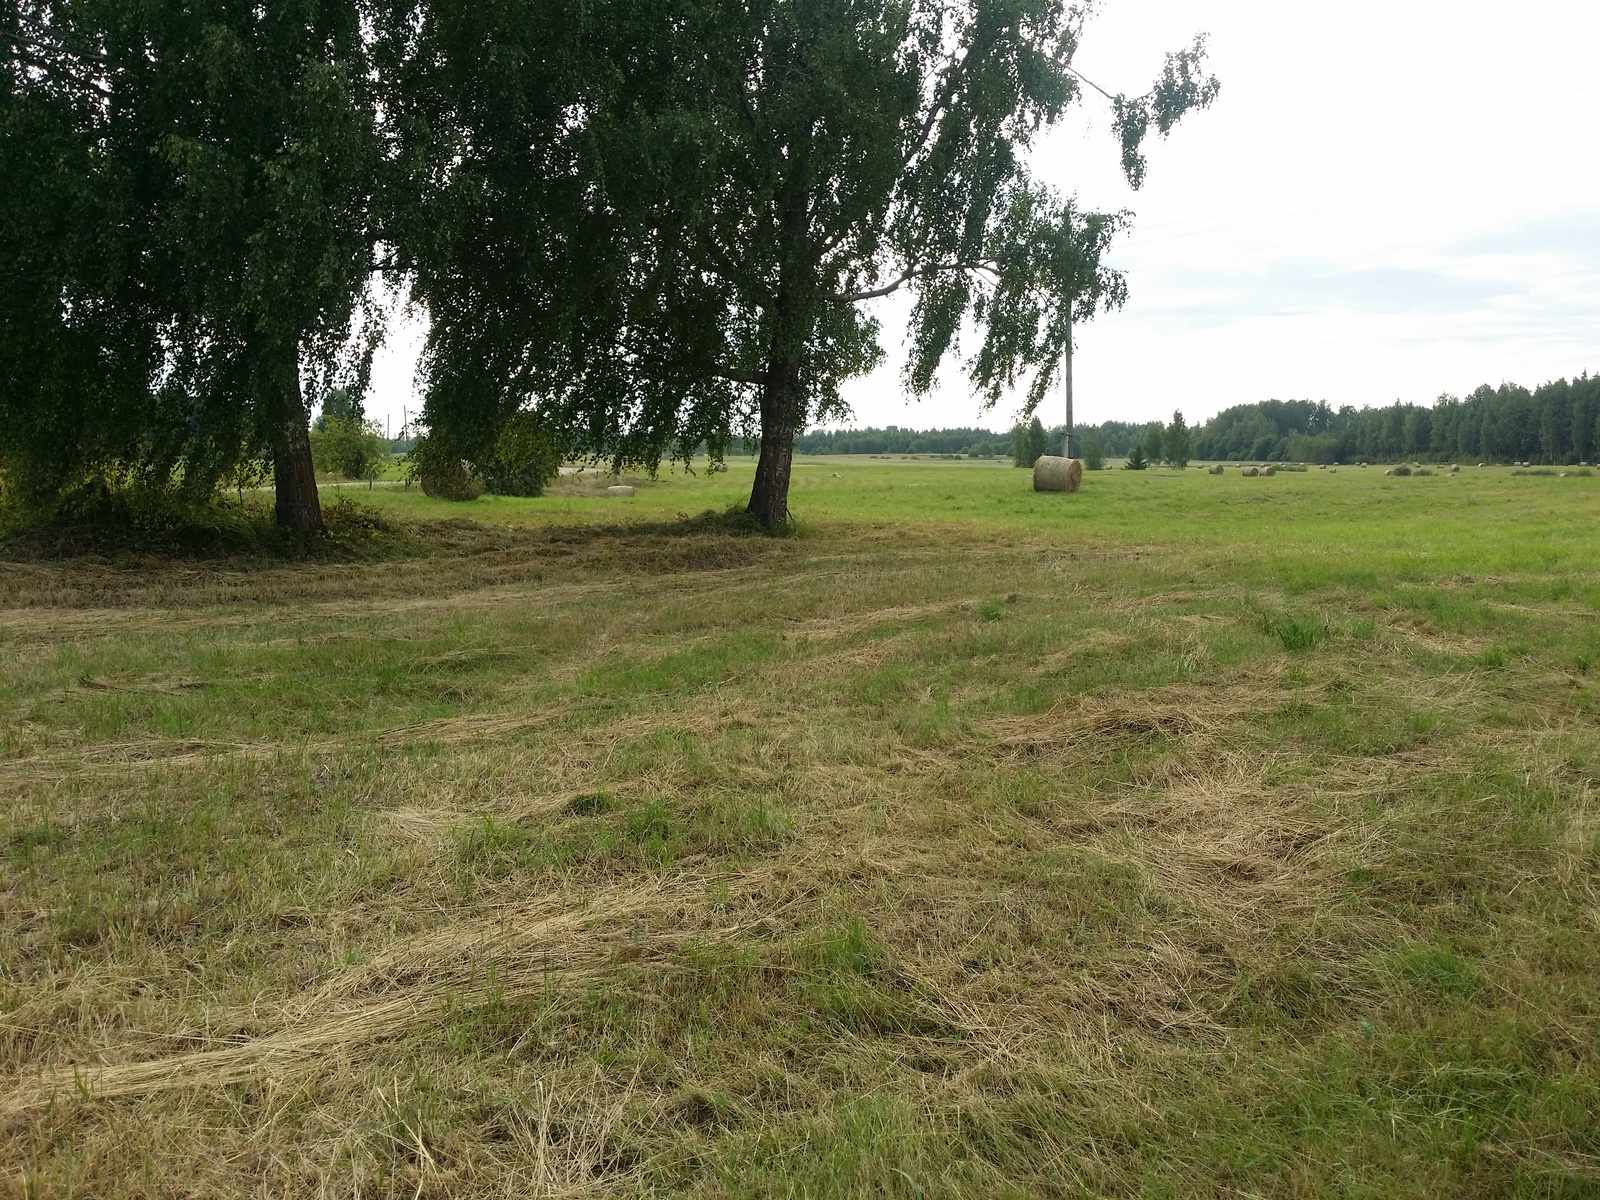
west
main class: Grassland
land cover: Grassland without tree/shrub cover
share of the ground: > 75 %
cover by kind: herbaceous plants 90 %, unconsolidated bare surface 10 %
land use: Agriculture (excluding fallow land and kitchen gardens)
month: August
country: LV
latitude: 56.9474
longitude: 27.2155
